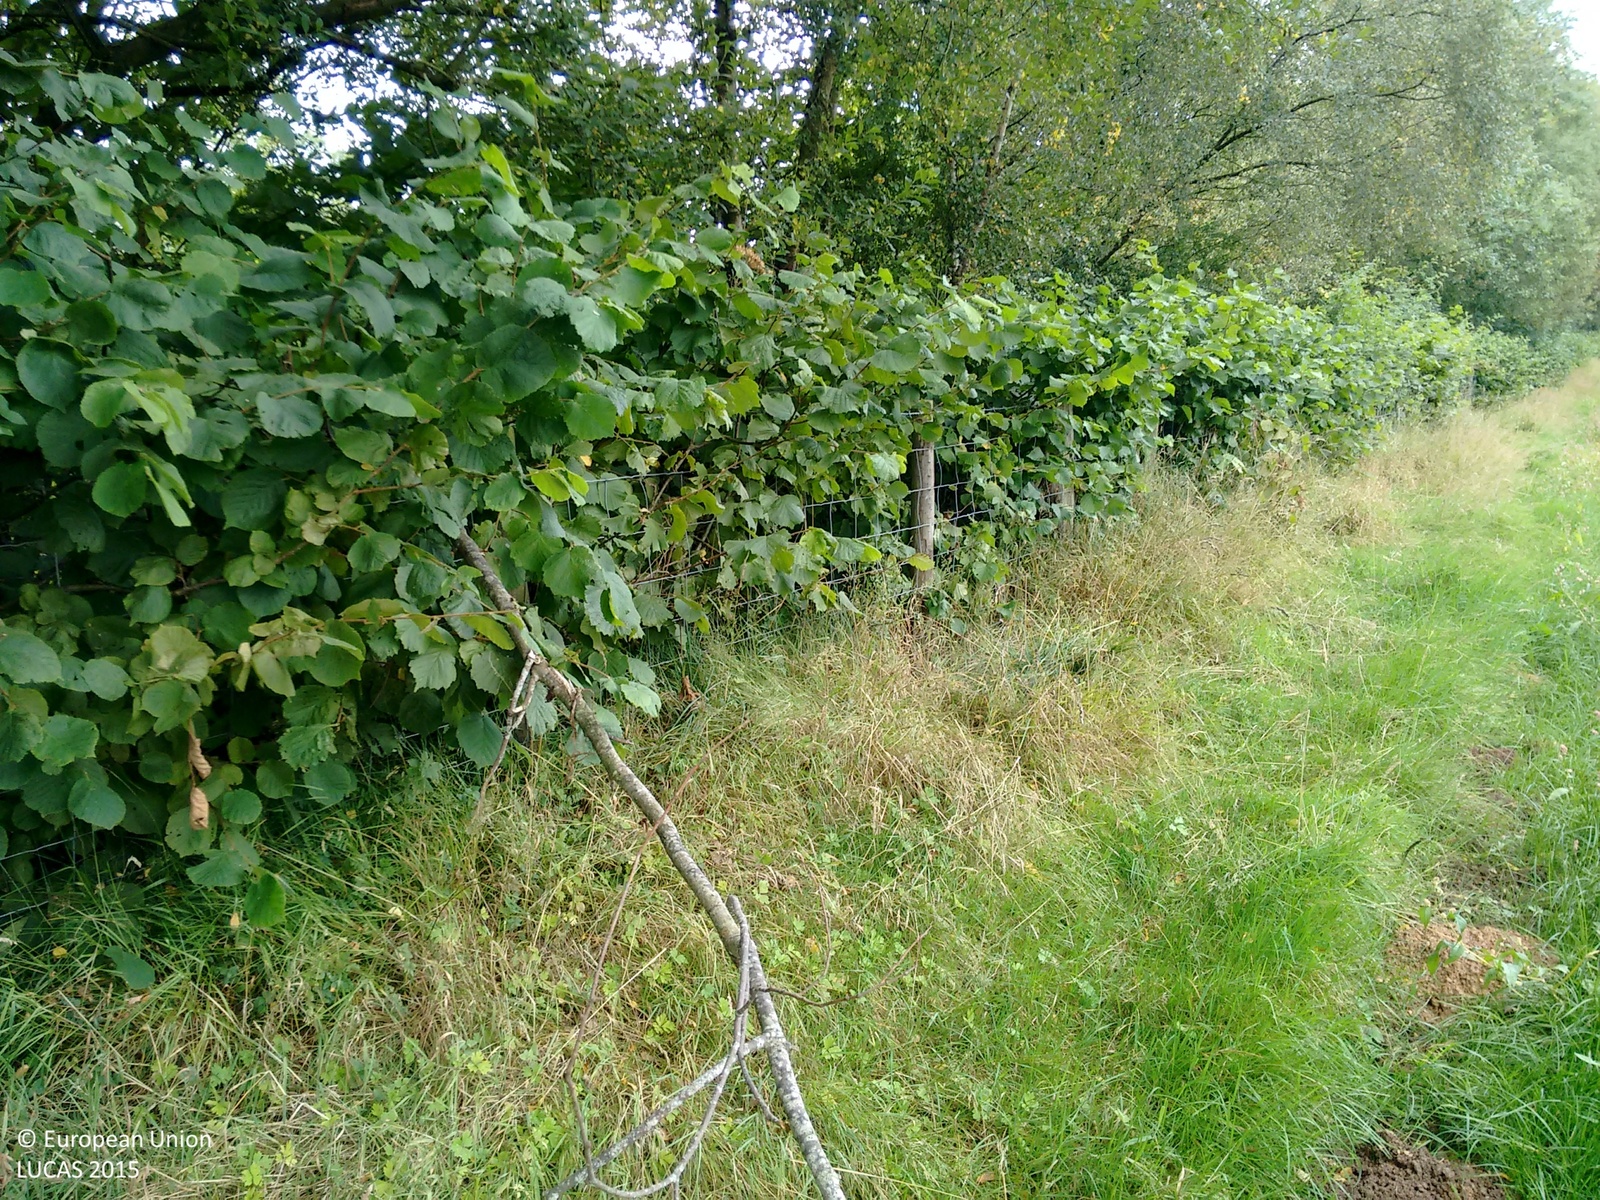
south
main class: Grassland
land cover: Grassland without tree/shrub cover
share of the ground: > 75 %
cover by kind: herbaceous plants 100 %
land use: Agriculture (excluding fallow land and kitchen gardens)
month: September
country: GB
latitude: 54.5348
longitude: -2.5047
